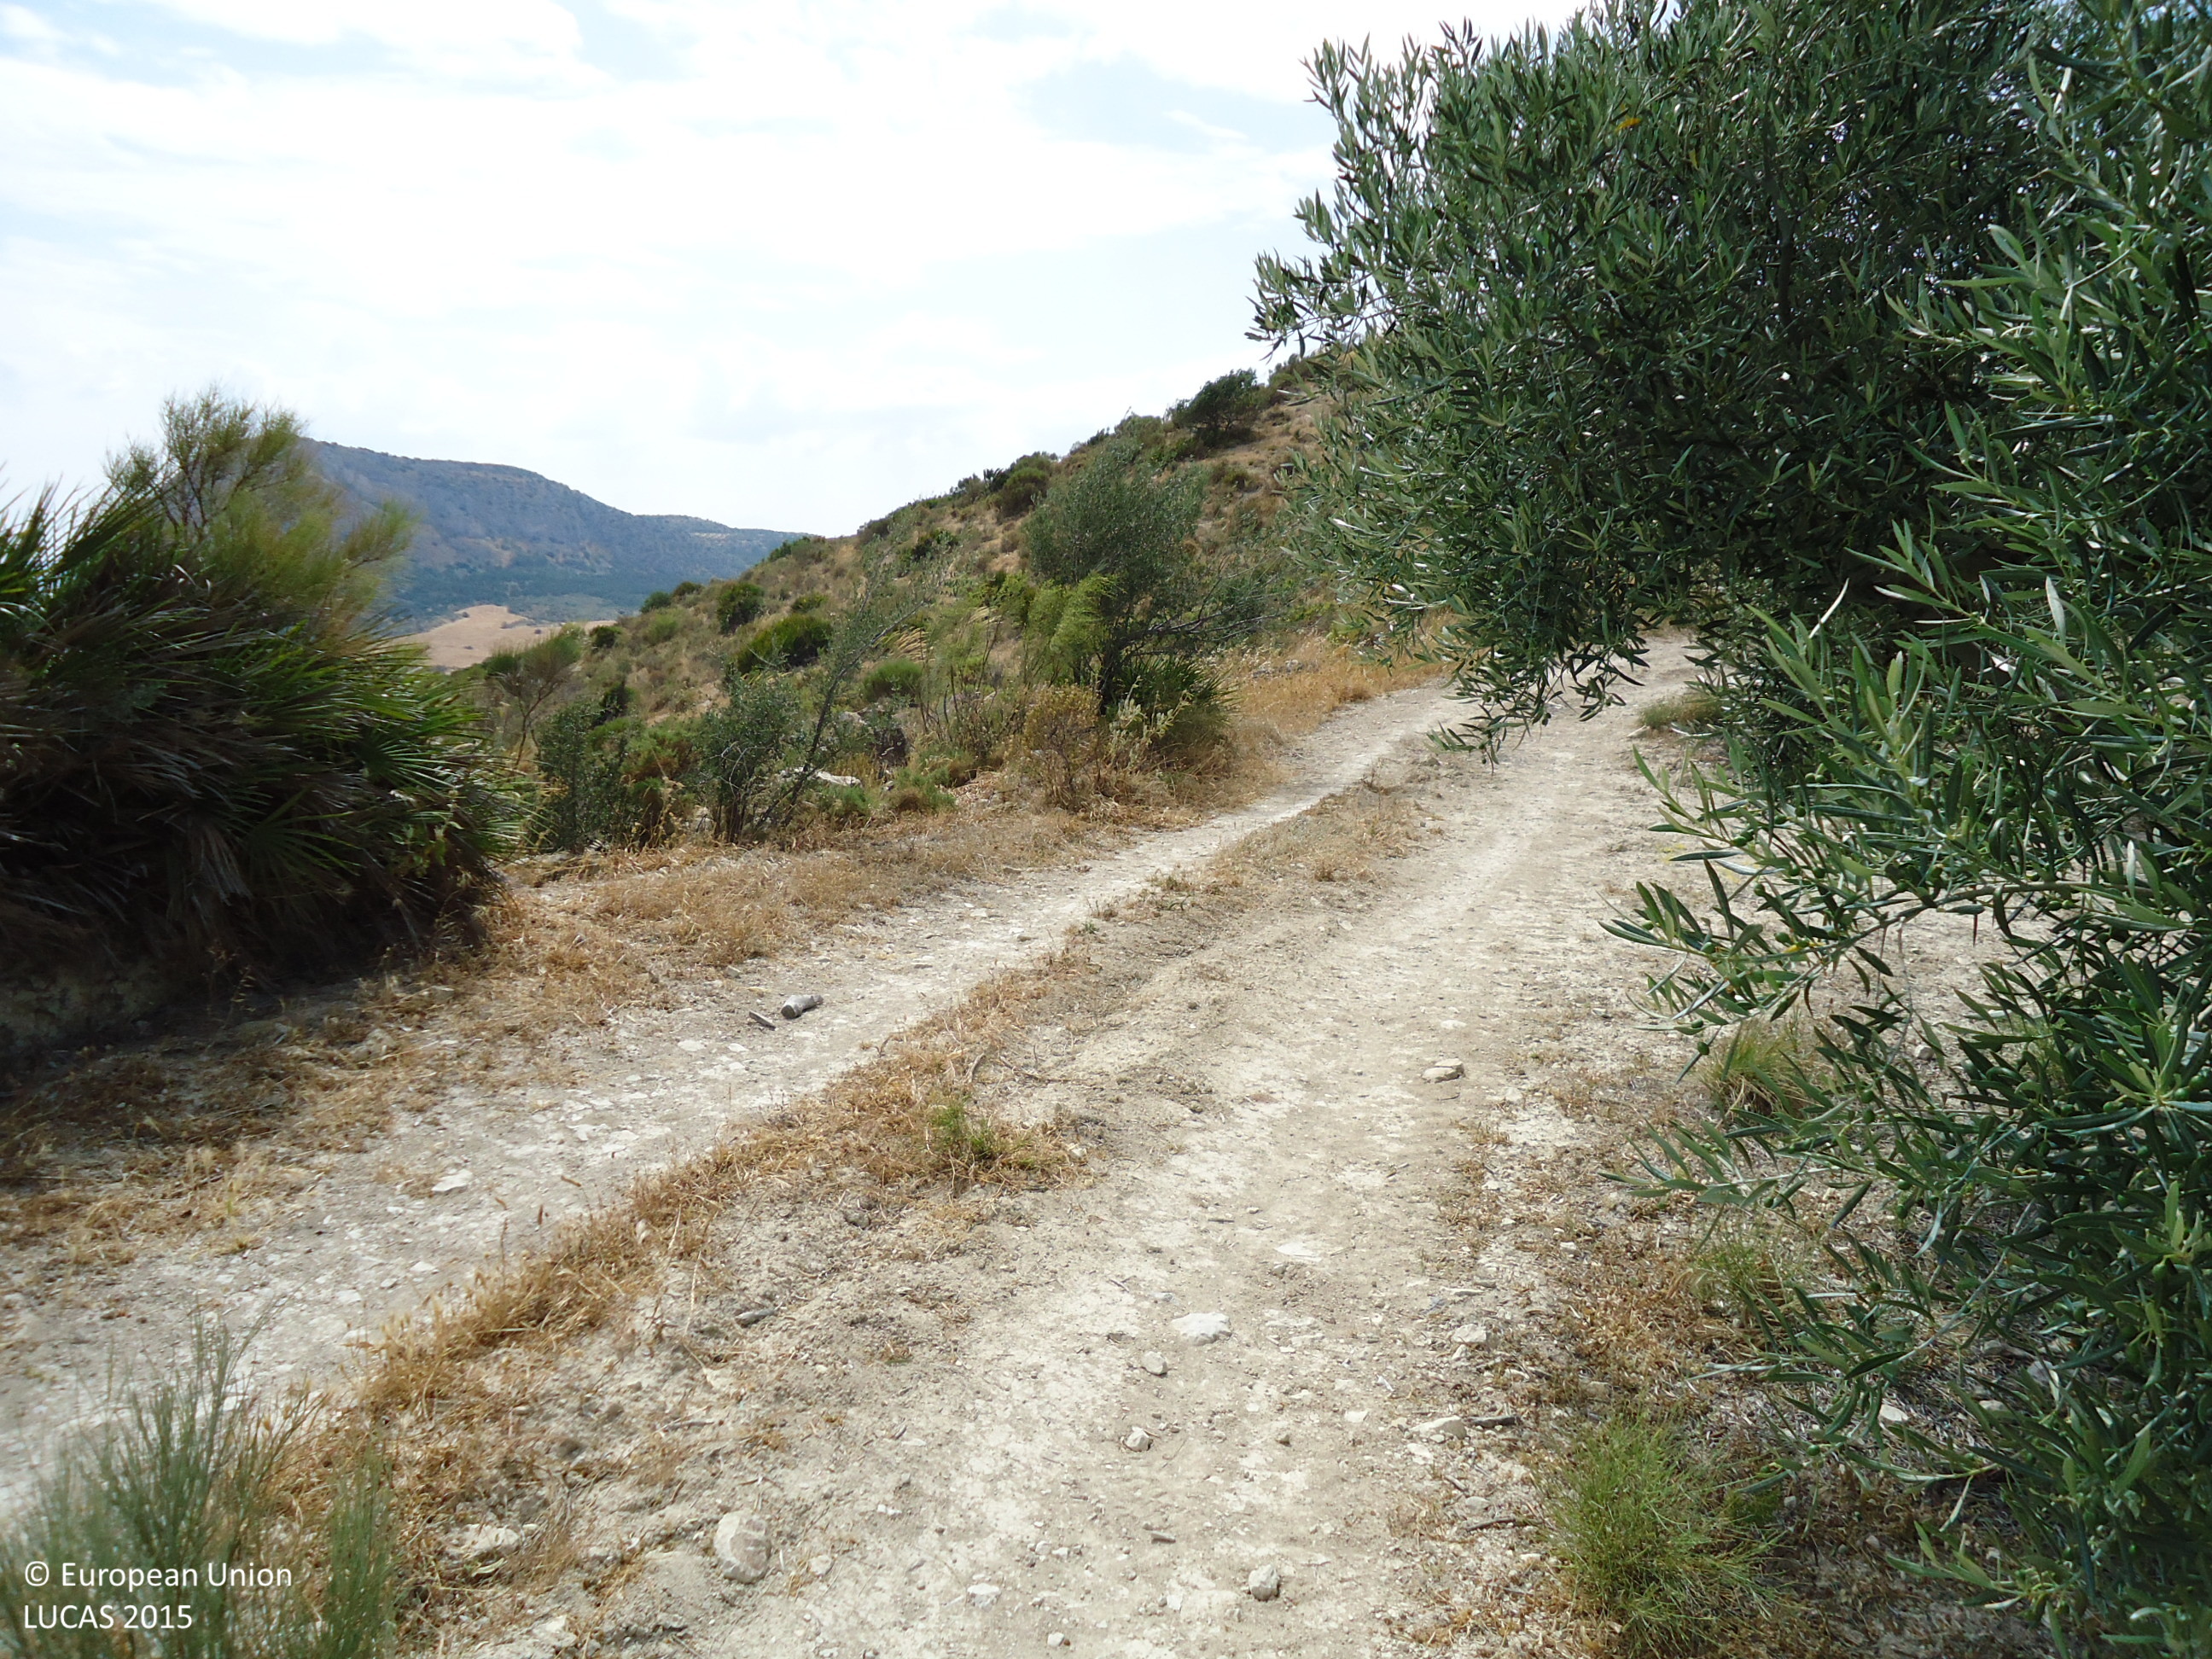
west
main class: Cropland
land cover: Olive groves
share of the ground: 25 - 50 %
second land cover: Other bare soil
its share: > 75 %
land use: Agriculture (excluding fallow land and kitchen gardens)
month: June
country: ES
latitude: 36.9845
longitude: -4.8178
